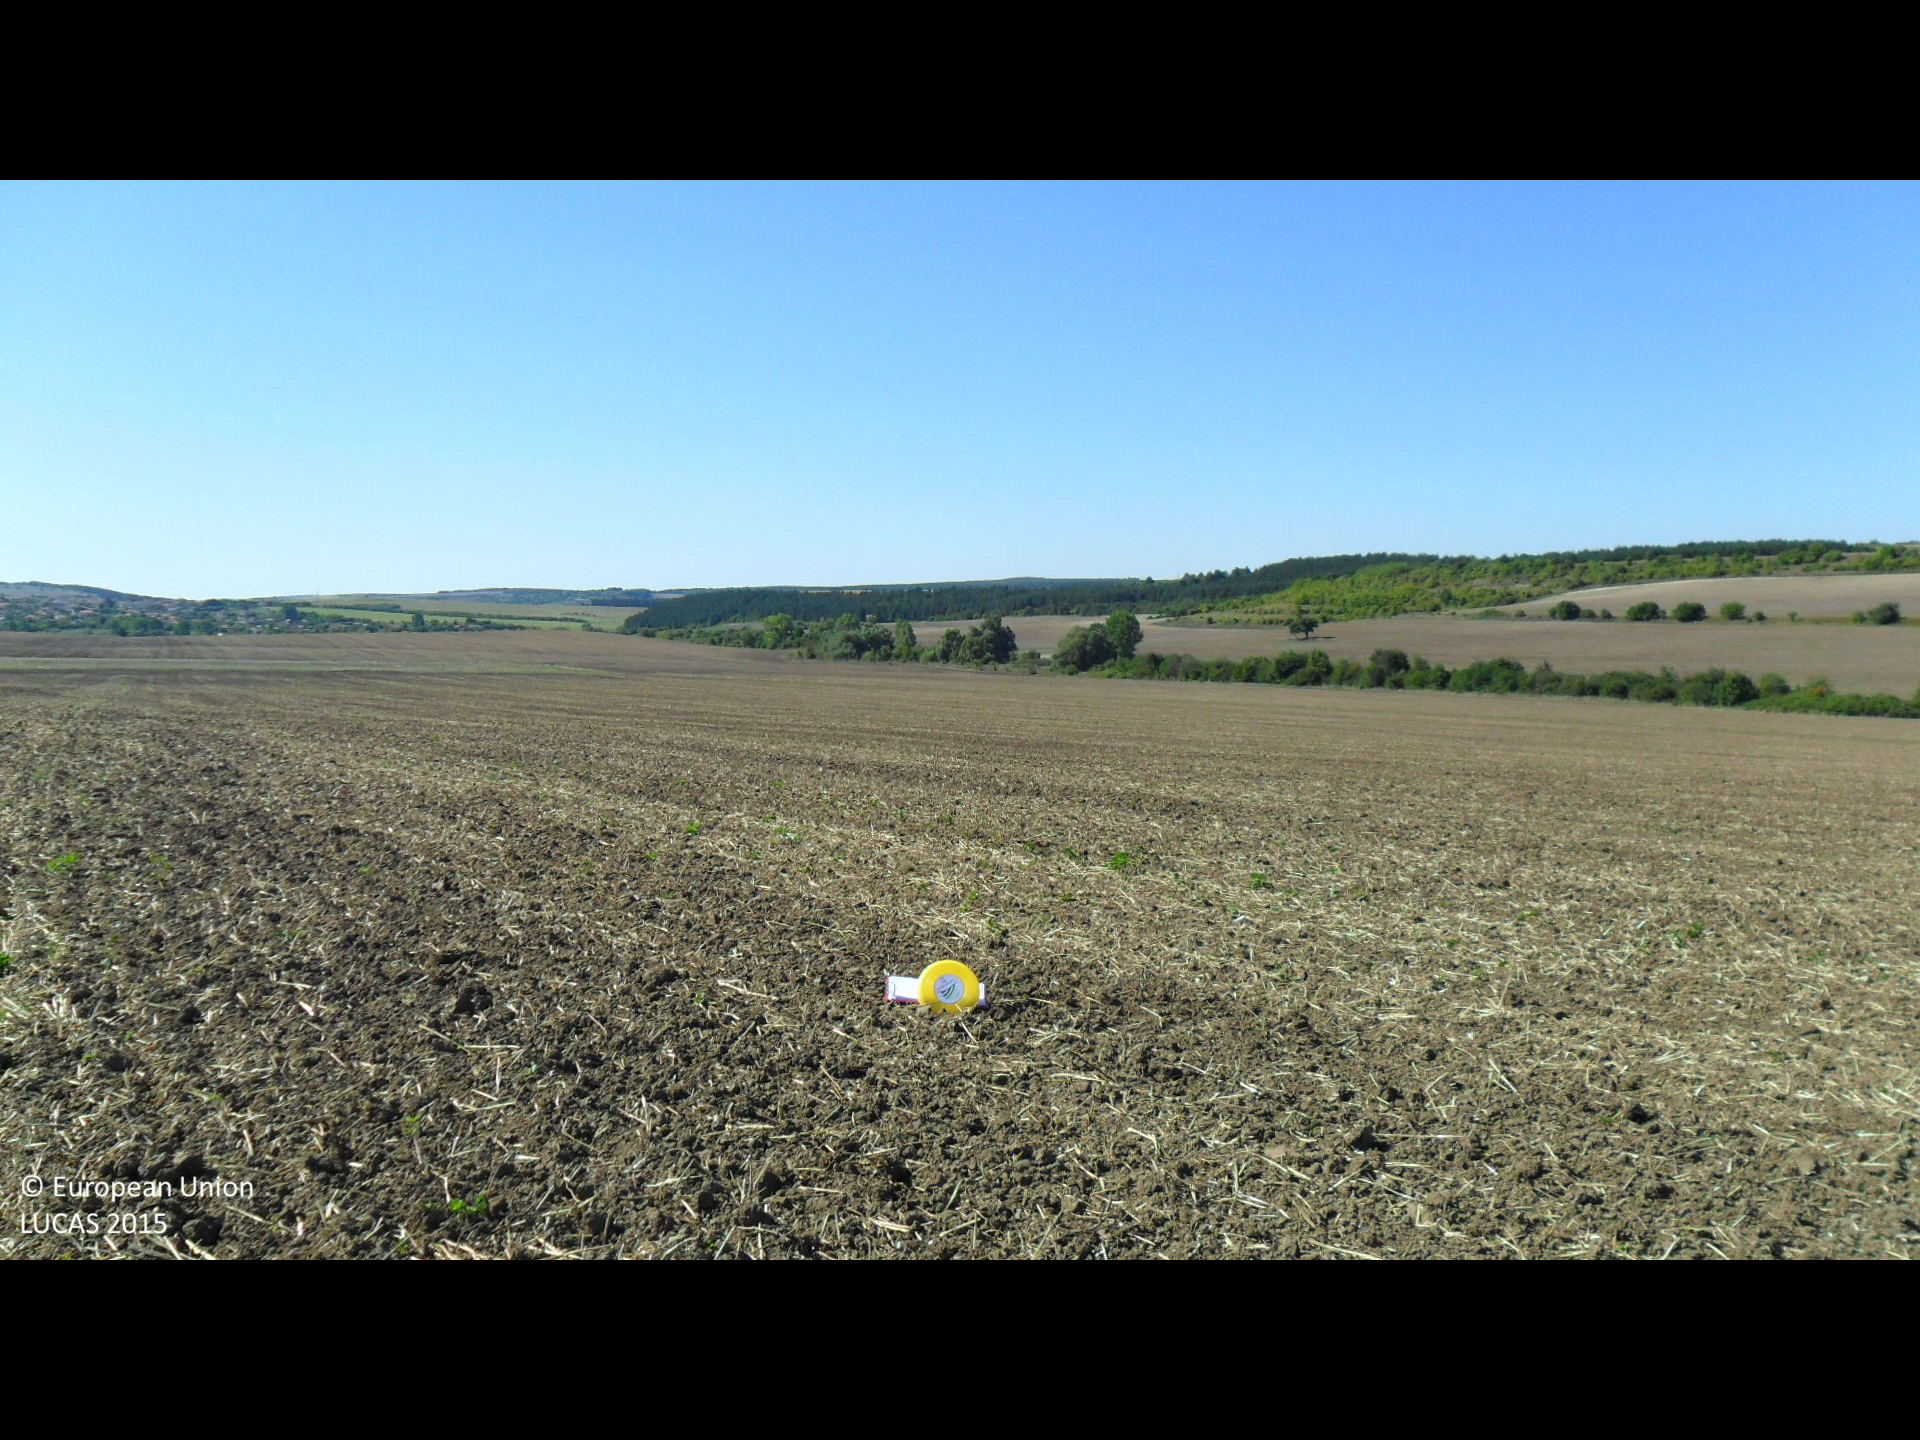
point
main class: Cropland
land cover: Common wheat
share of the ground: < 10 %
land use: Agriculture (excluding fallow land and kitchen gardens)
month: September
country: BG
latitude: 43.1351
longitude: 26.4623
